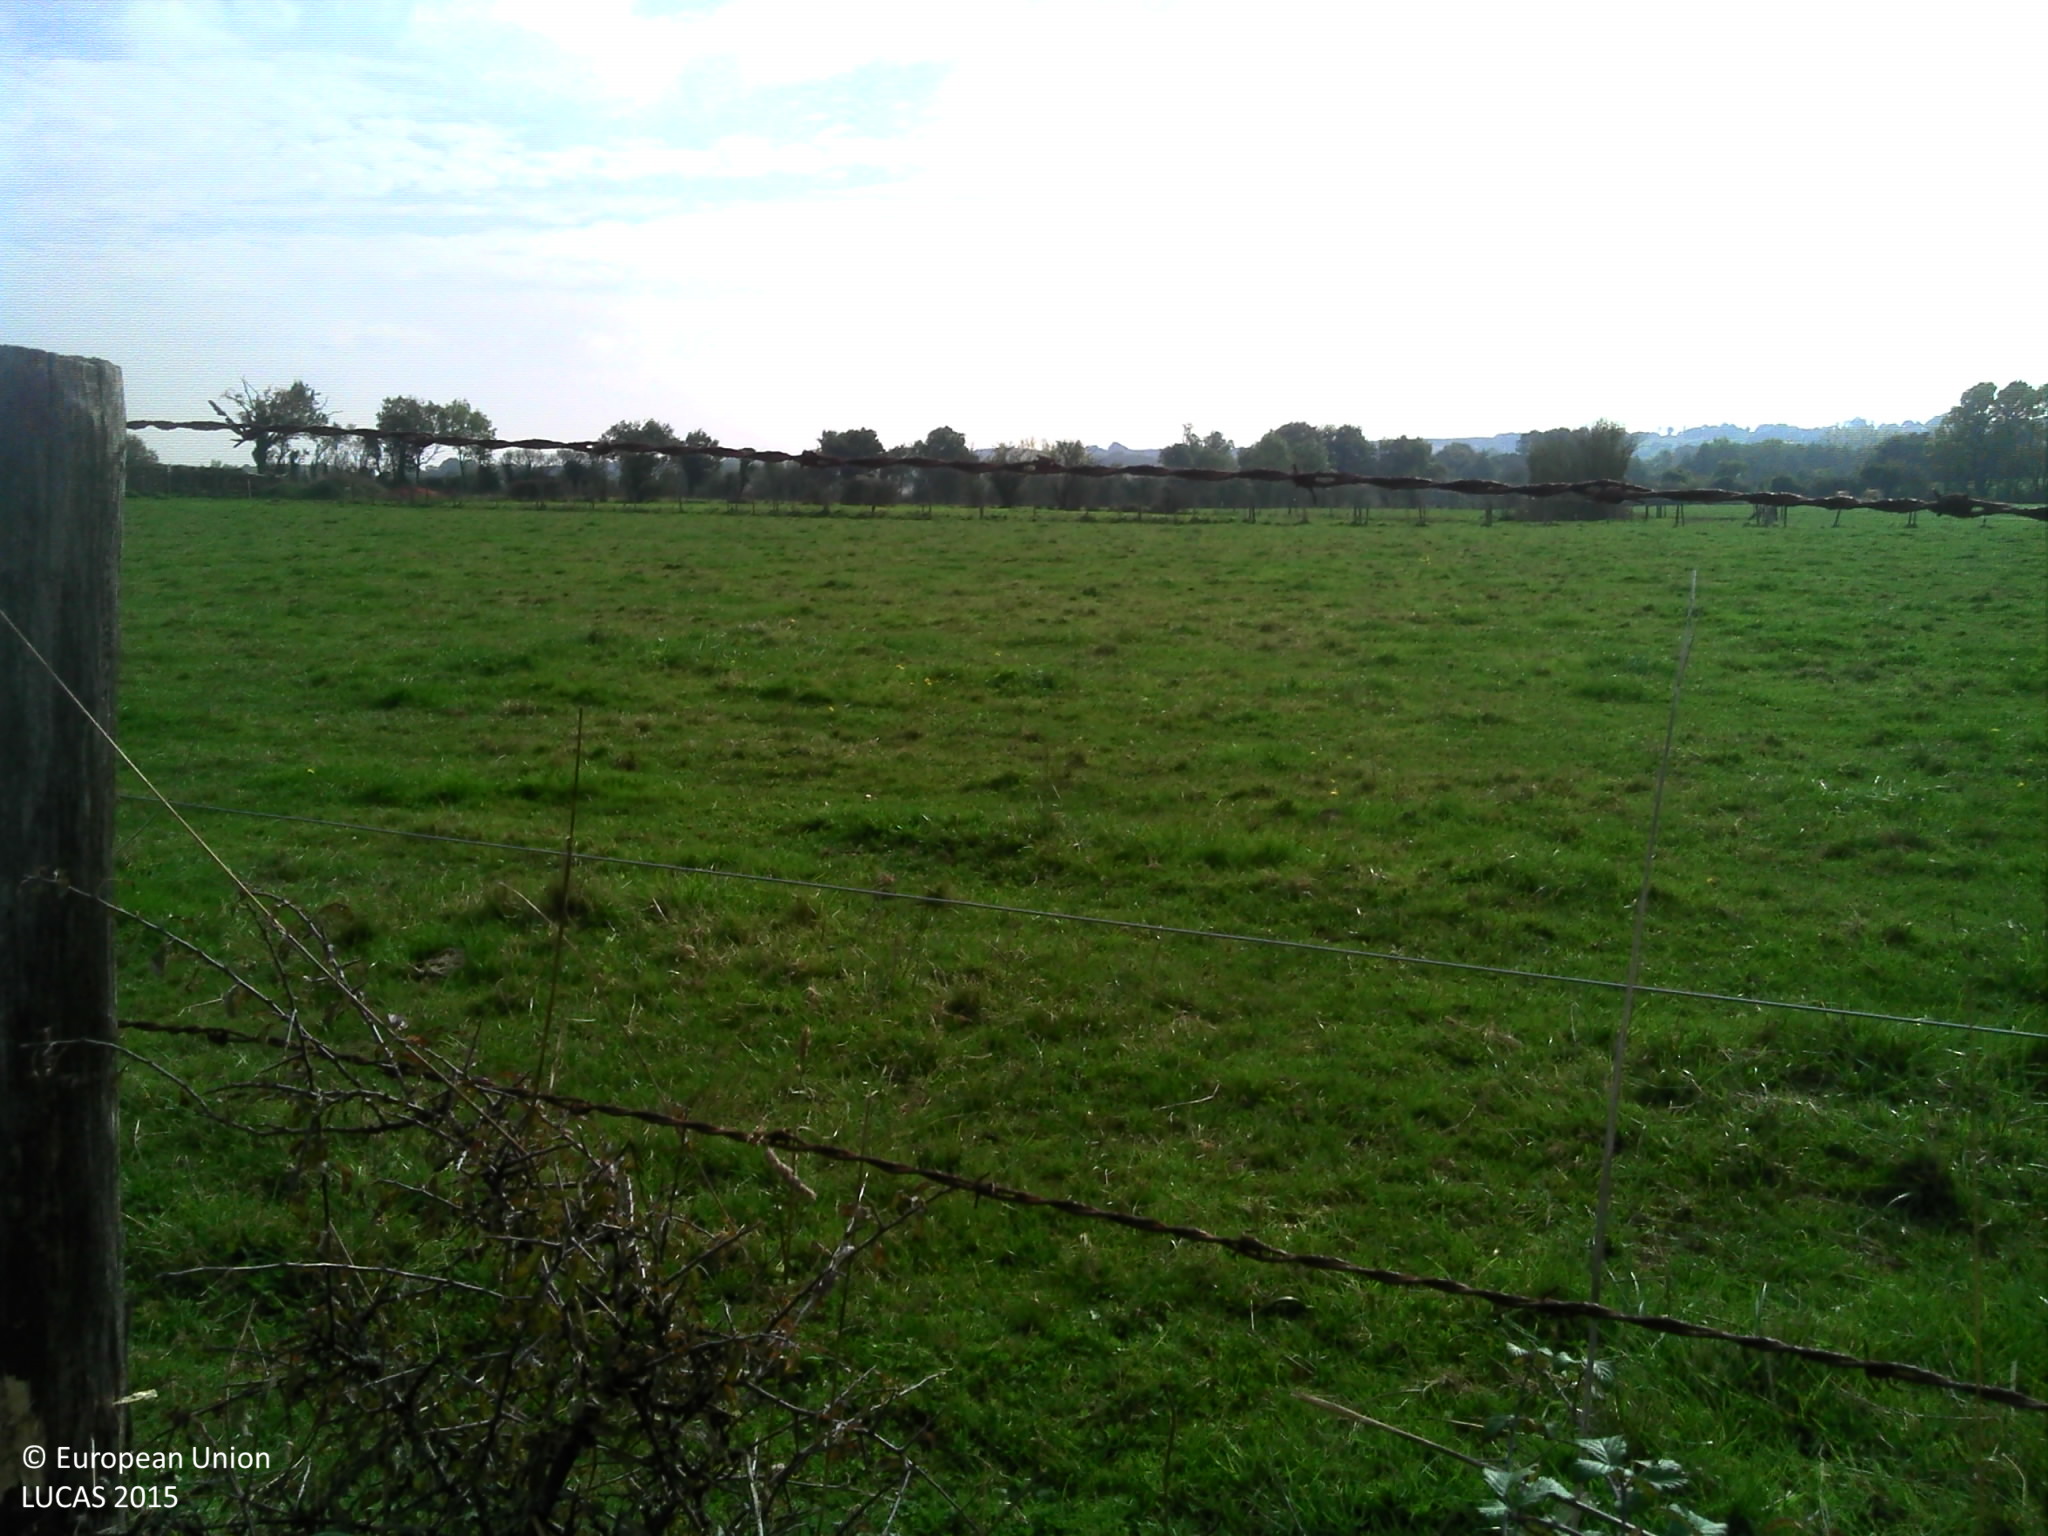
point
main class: Grassland
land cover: Grassland without tree/shrub cover
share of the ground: > 75 %
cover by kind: herbaceous plants 100 %
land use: Agriculture (excluding fallow land and kitchen gardens)
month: October
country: FR
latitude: 47.0920
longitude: -0.9819
